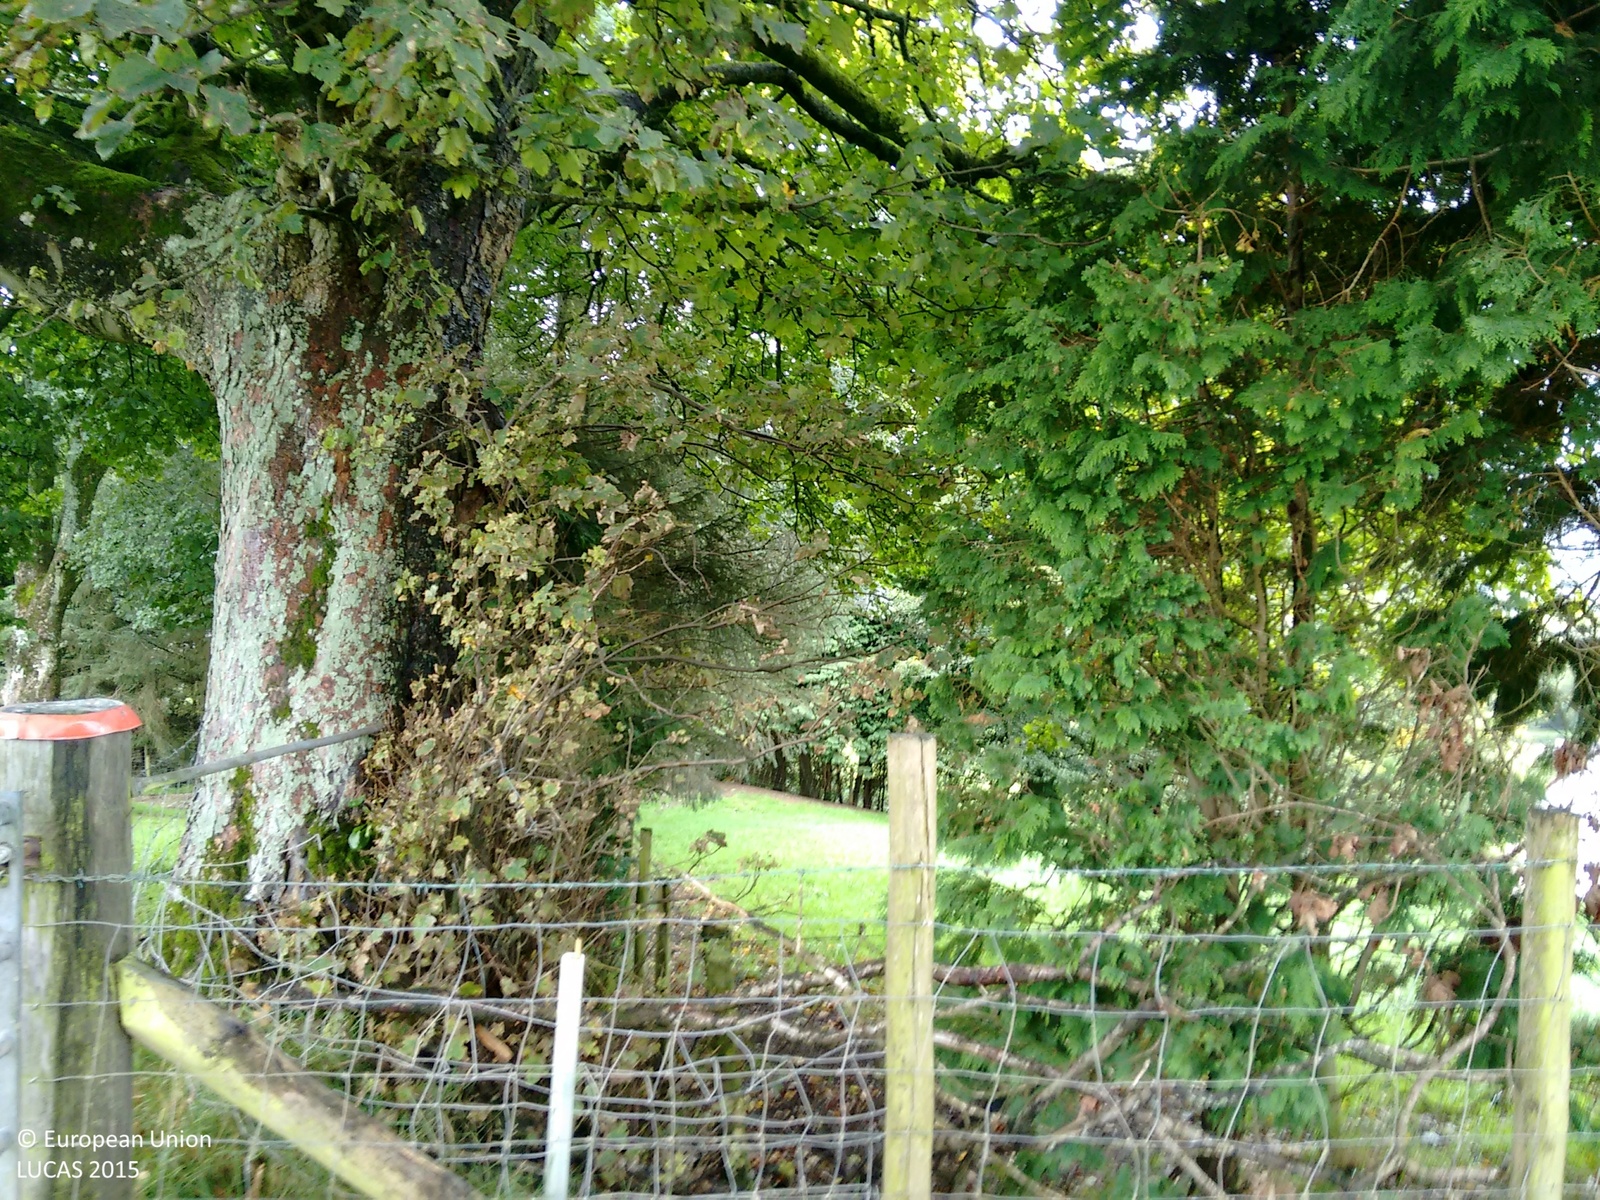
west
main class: Woodland
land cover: Broadleaved woodland
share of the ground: > 75 %
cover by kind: broadleaved forest trees 60 %, herbaceous plants 40 %
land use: Agriculture (excluding fallow land and kitchen gardens)
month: September
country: GB
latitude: 52.2265
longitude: -3.9278
